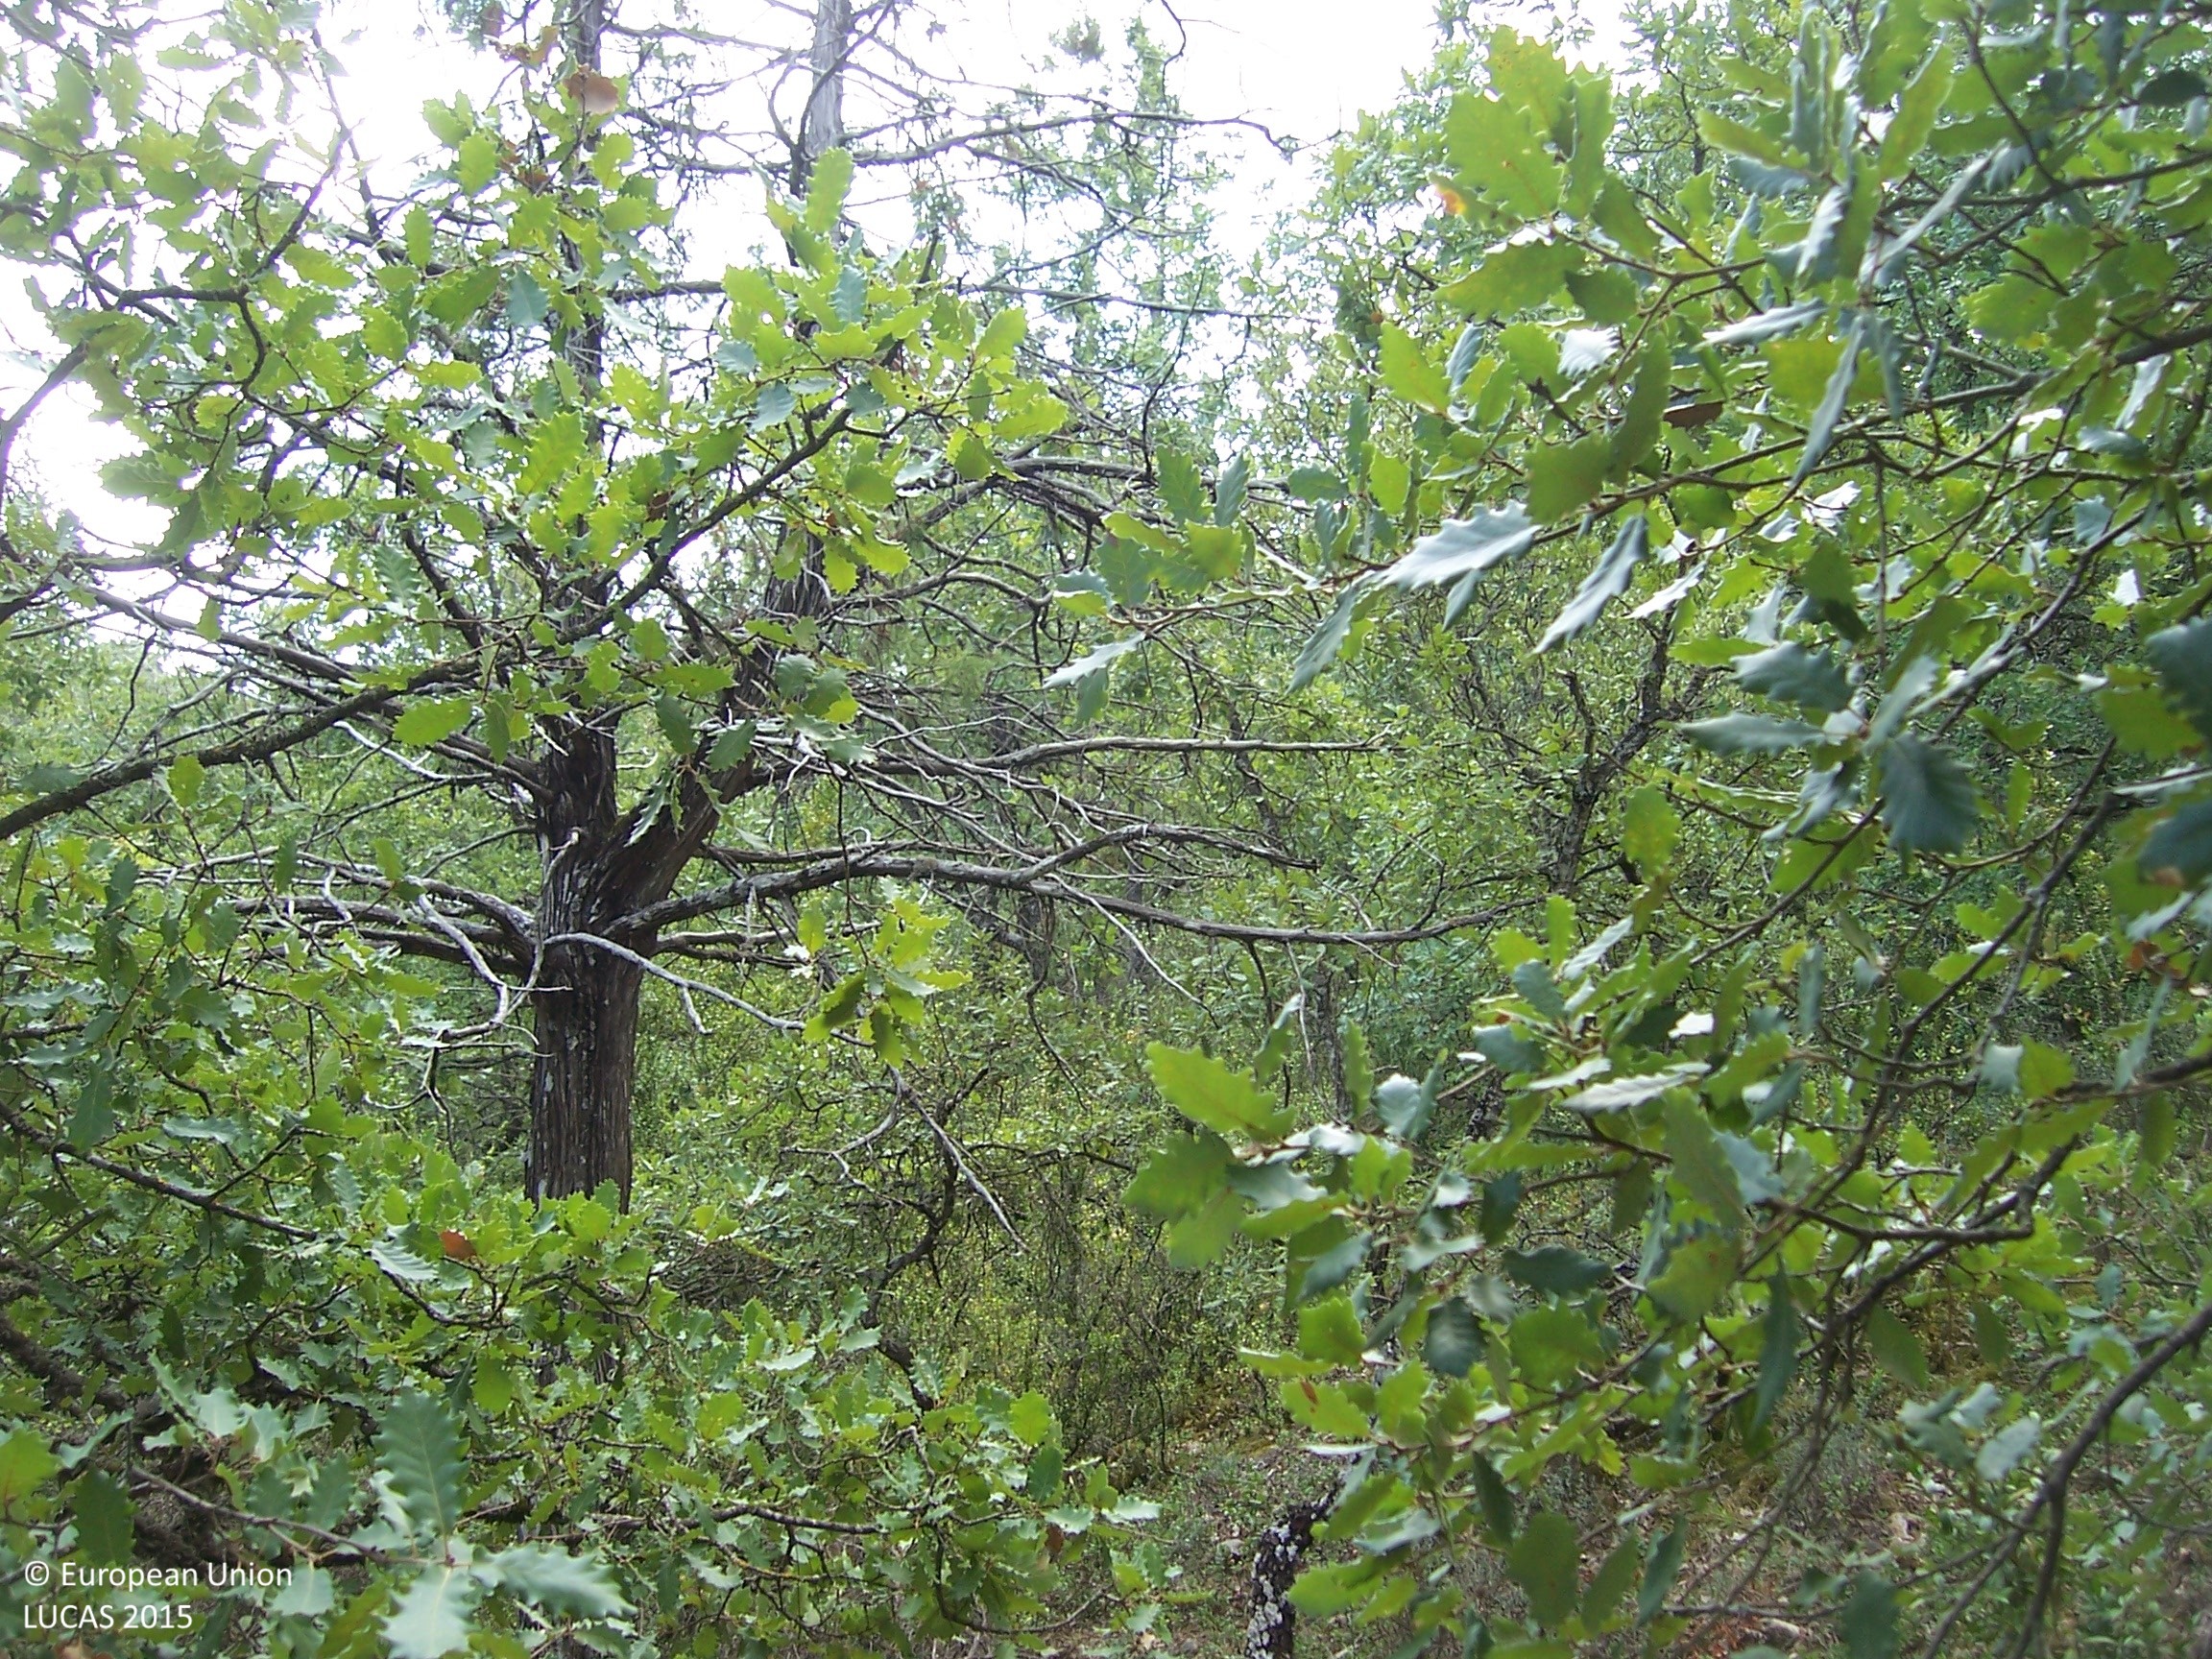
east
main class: Woodland
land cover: Broadleaved woodland
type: broadleaved evergreen forest
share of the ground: > 75 %
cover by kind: broadleaved forest trees 80 %, shrubs 10 %, herbaceous plants 10 %
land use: Semi-natural and natural areas not in use
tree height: > 5 m
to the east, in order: Broadleaved woodland; Tracks; Broadleaved woodland
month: August
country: ES
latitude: 42.0587
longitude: 0.4735
